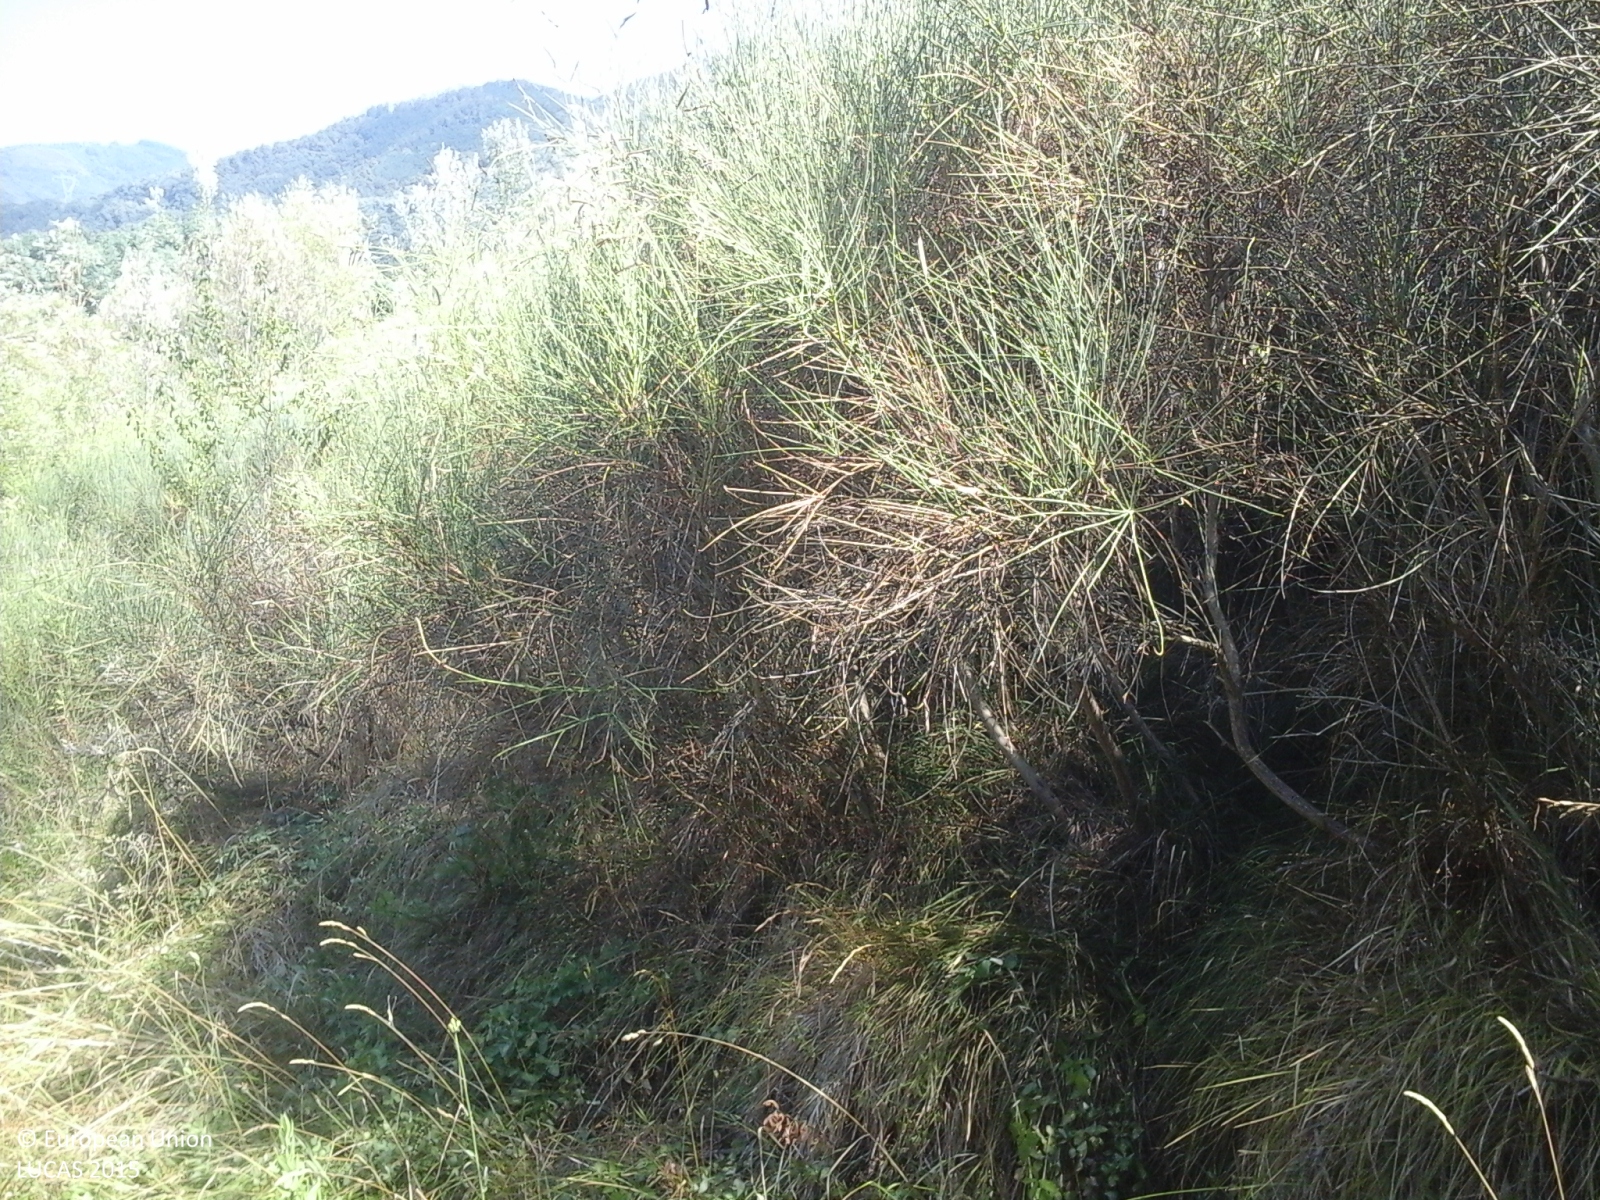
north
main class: Shrubland
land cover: Shrubland without tree cover
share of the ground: > 75 %
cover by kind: shrubs 100 %
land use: Abandoned areas
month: August
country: IT
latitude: 43.8978
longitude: 10.6085
